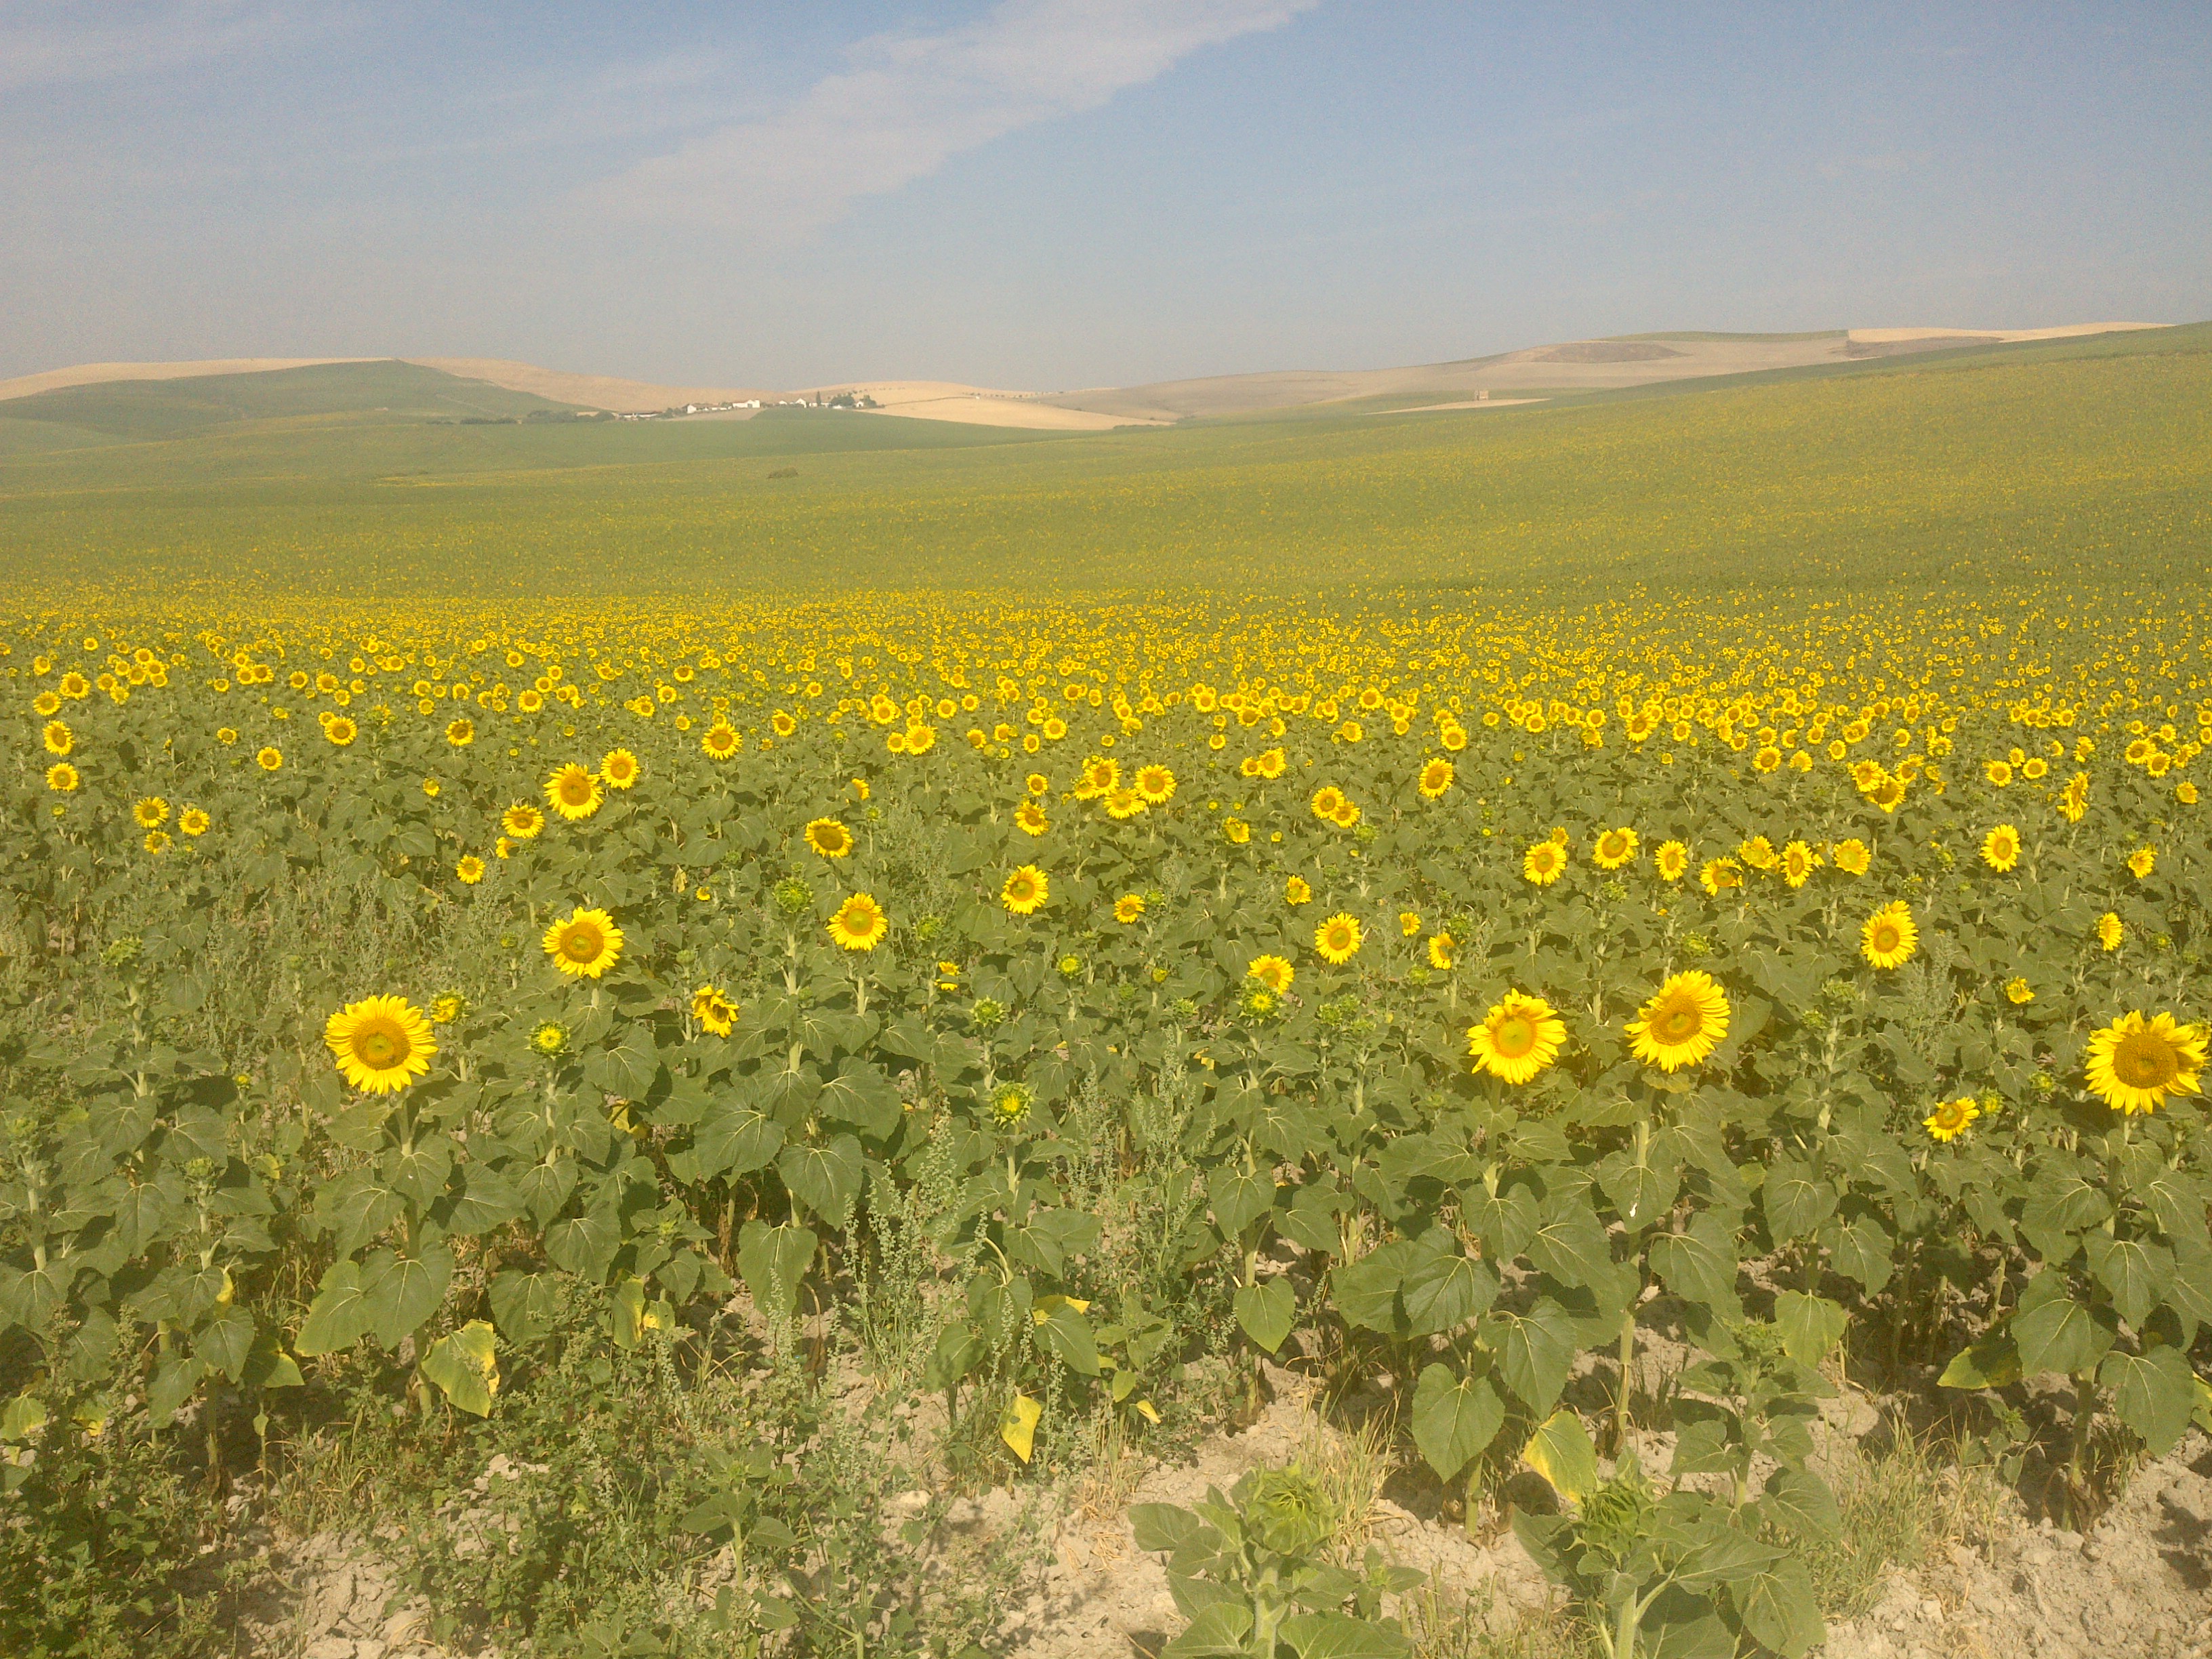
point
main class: Cropland
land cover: Sunflower
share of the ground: > 75 %
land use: Agriculture (excluding fallow land and kitchen gardens)
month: May
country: ES
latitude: 37.7763
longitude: -4.5765
